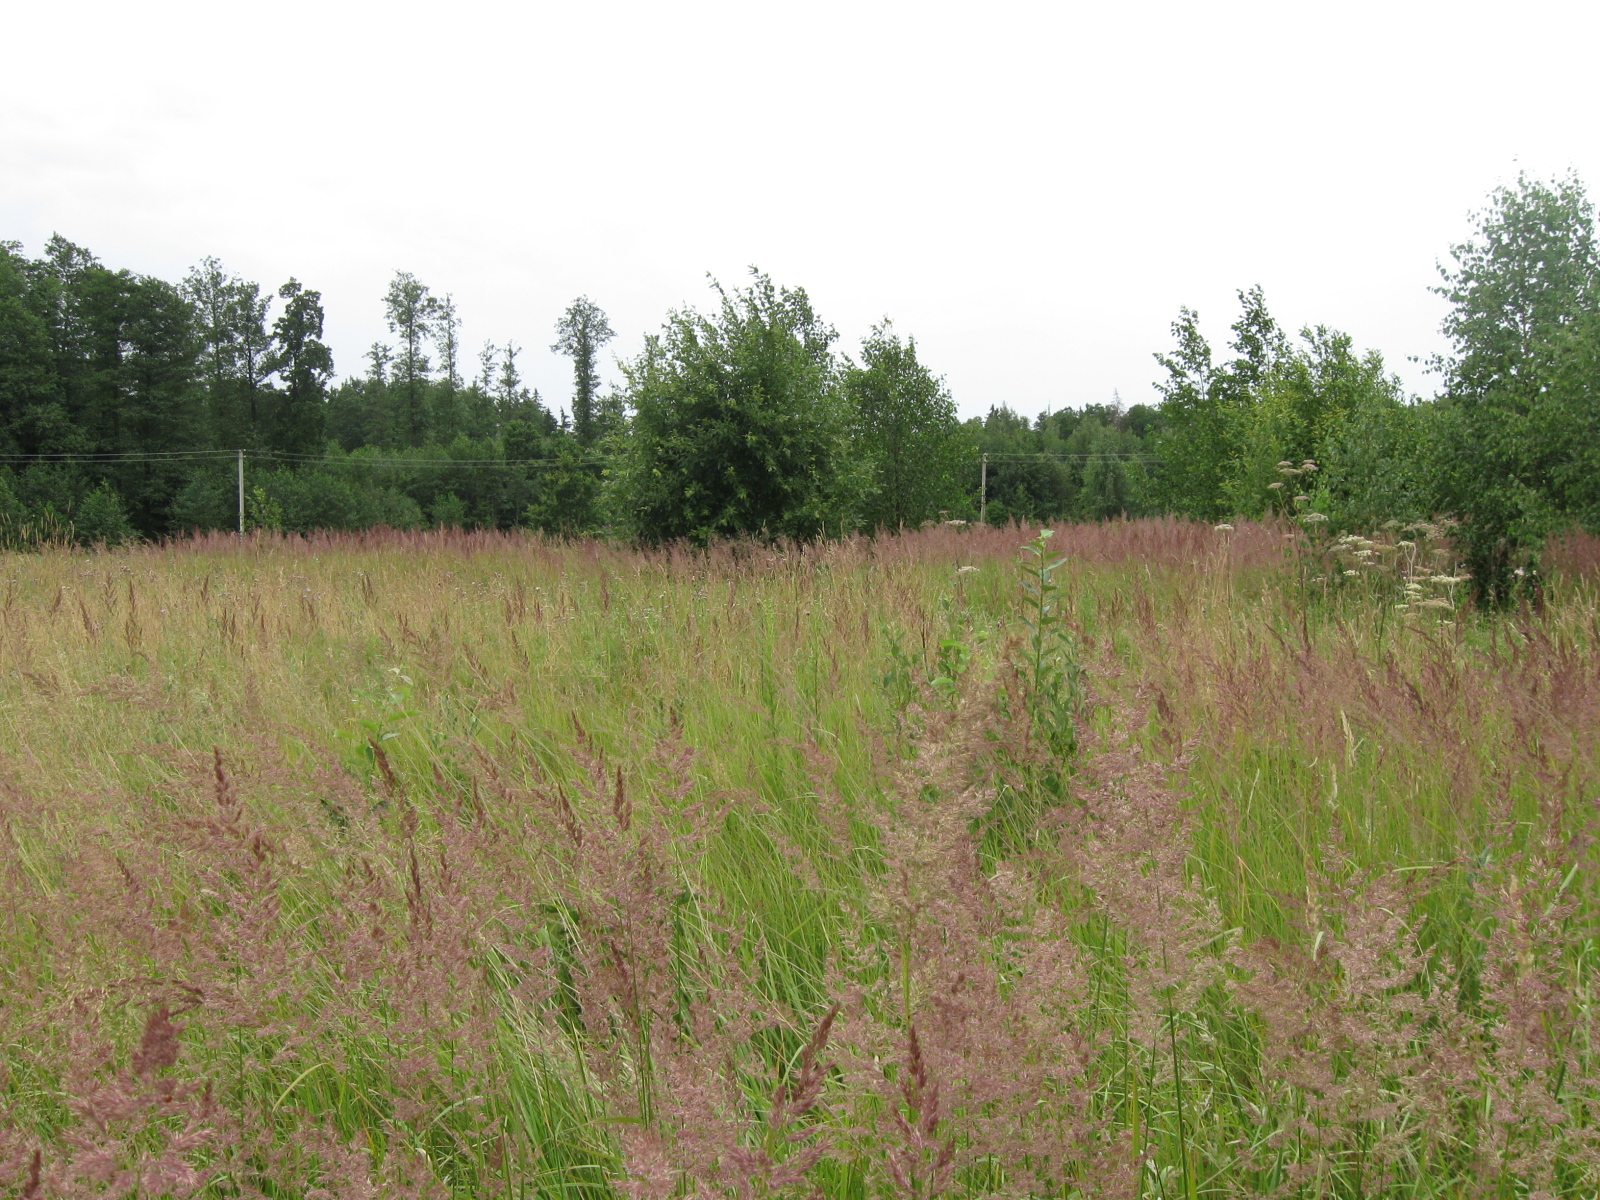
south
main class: Woodland
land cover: Broadleaved woodland
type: non-riverine alder, birch or aspen forest
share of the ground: 25 - 50 %
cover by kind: herbaceous plants 75 %, broadleaved forest trees 25 %
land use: Semi-natural and natural areas not in use
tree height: < 5 m
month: July
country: LT
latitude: 54.8408
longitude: 23.7419
